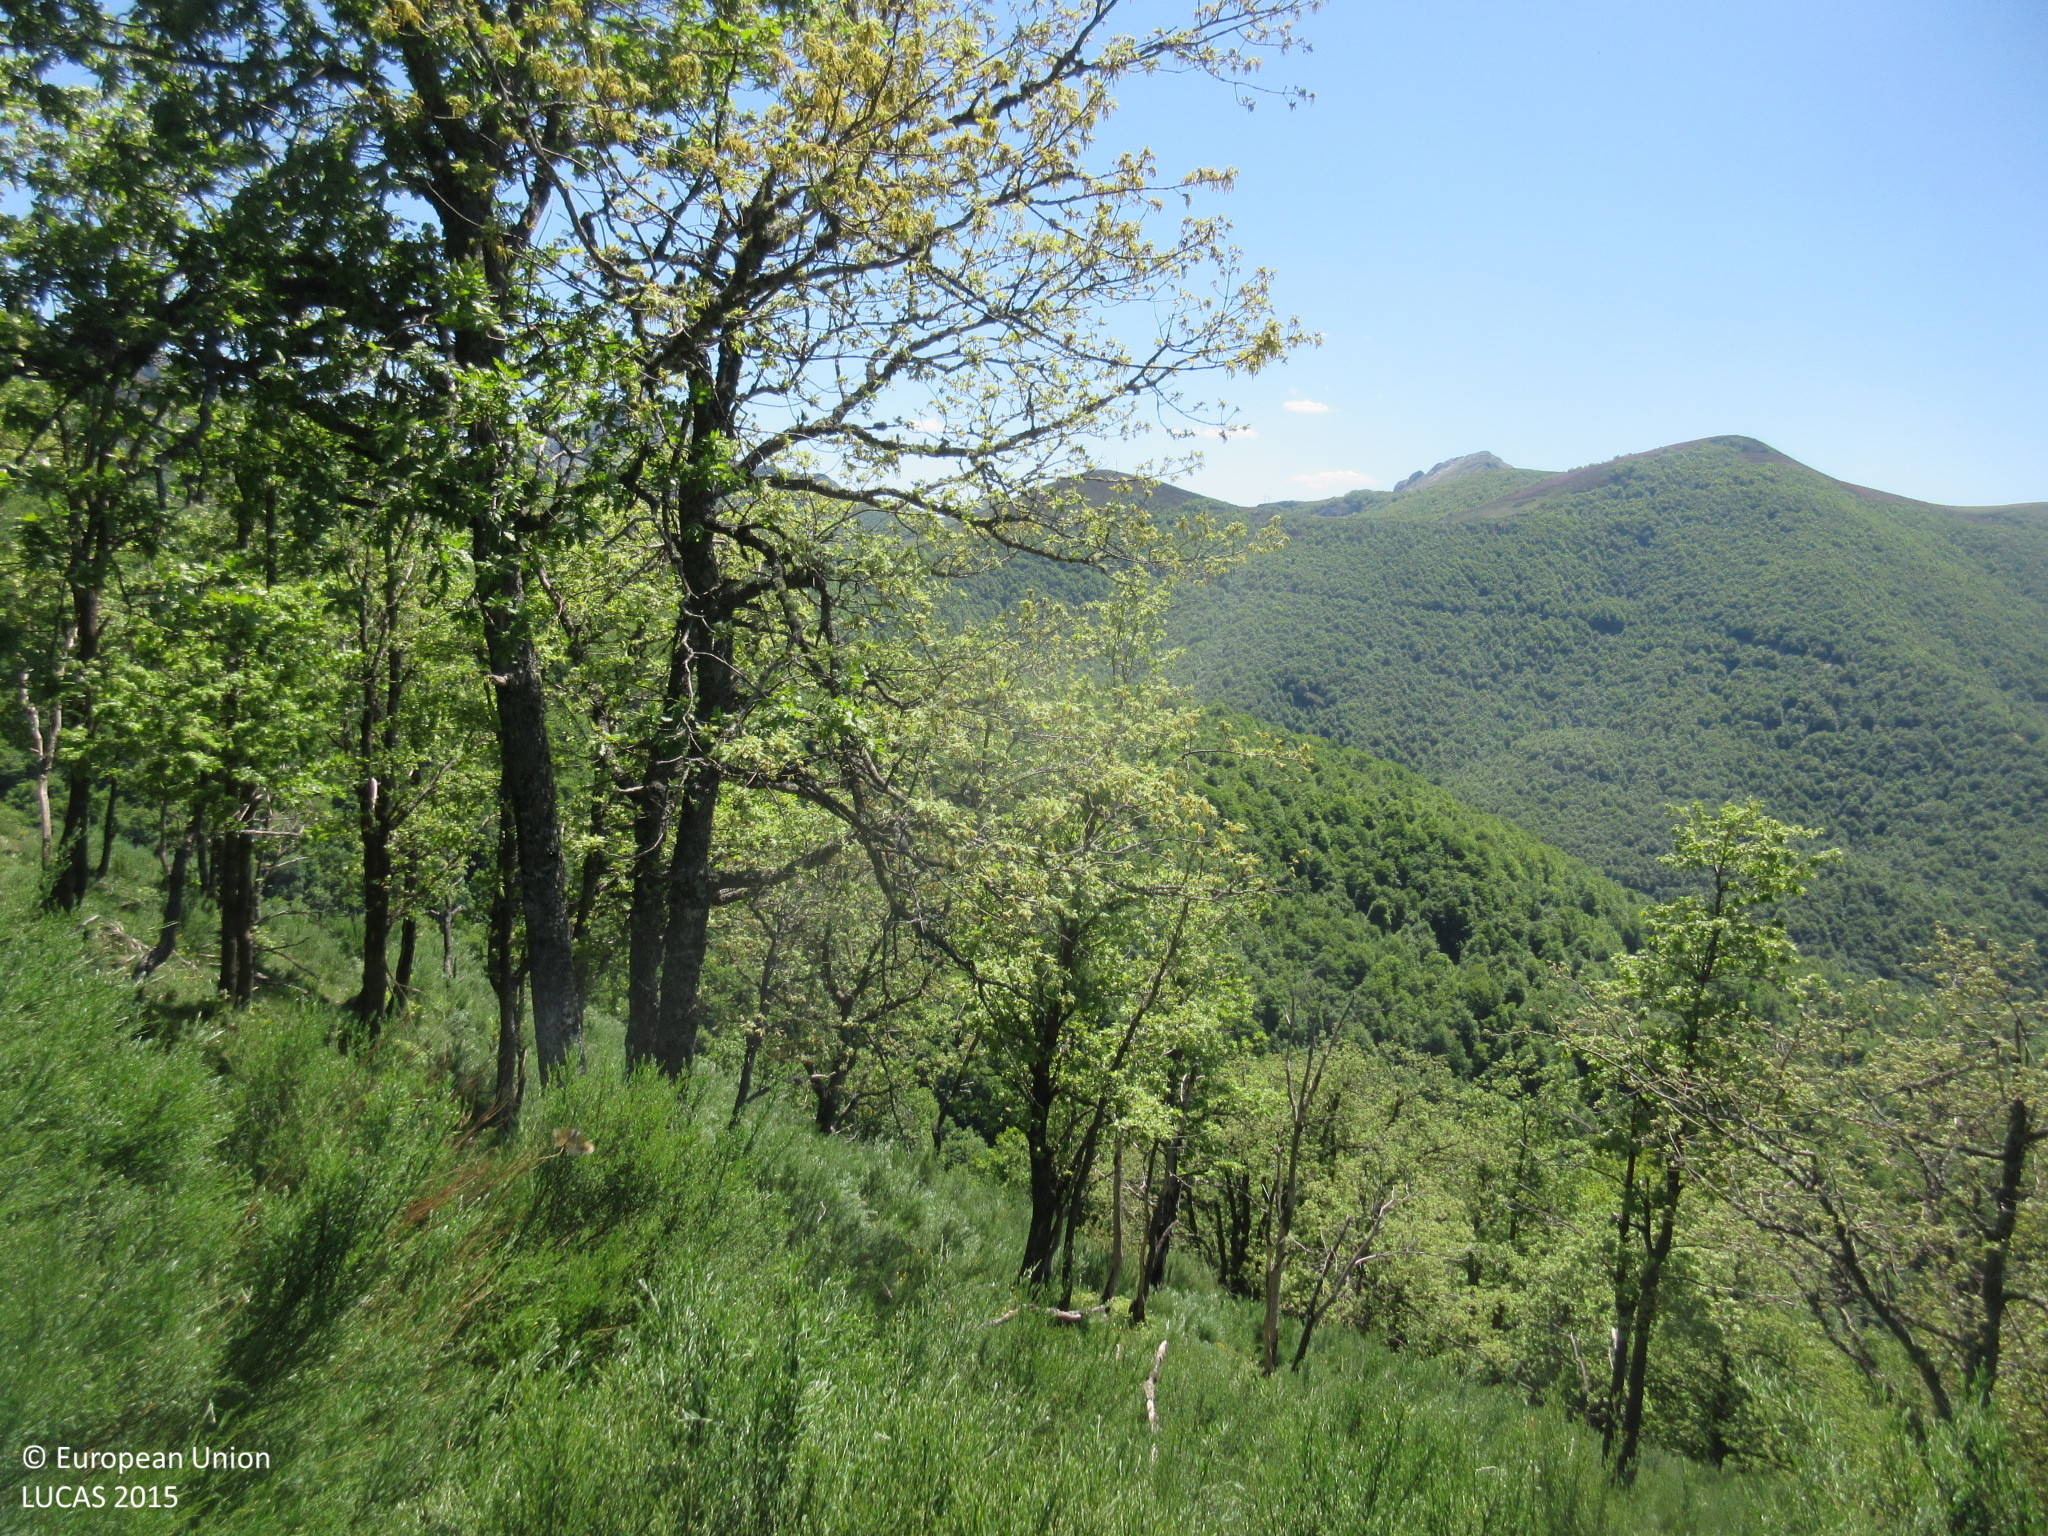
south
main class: Shrubland
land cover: Shrubland with sparse tree cover
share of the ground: > 75 %
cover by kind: shrubs 80 %, herbaceous plants 15 %, broadleaved forest trees 5 %
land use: Agriculture (excluding fallow land and kitchen gardens)
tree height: < 5 m
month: June
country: ES
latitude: 43.0571
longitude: -4.4585
